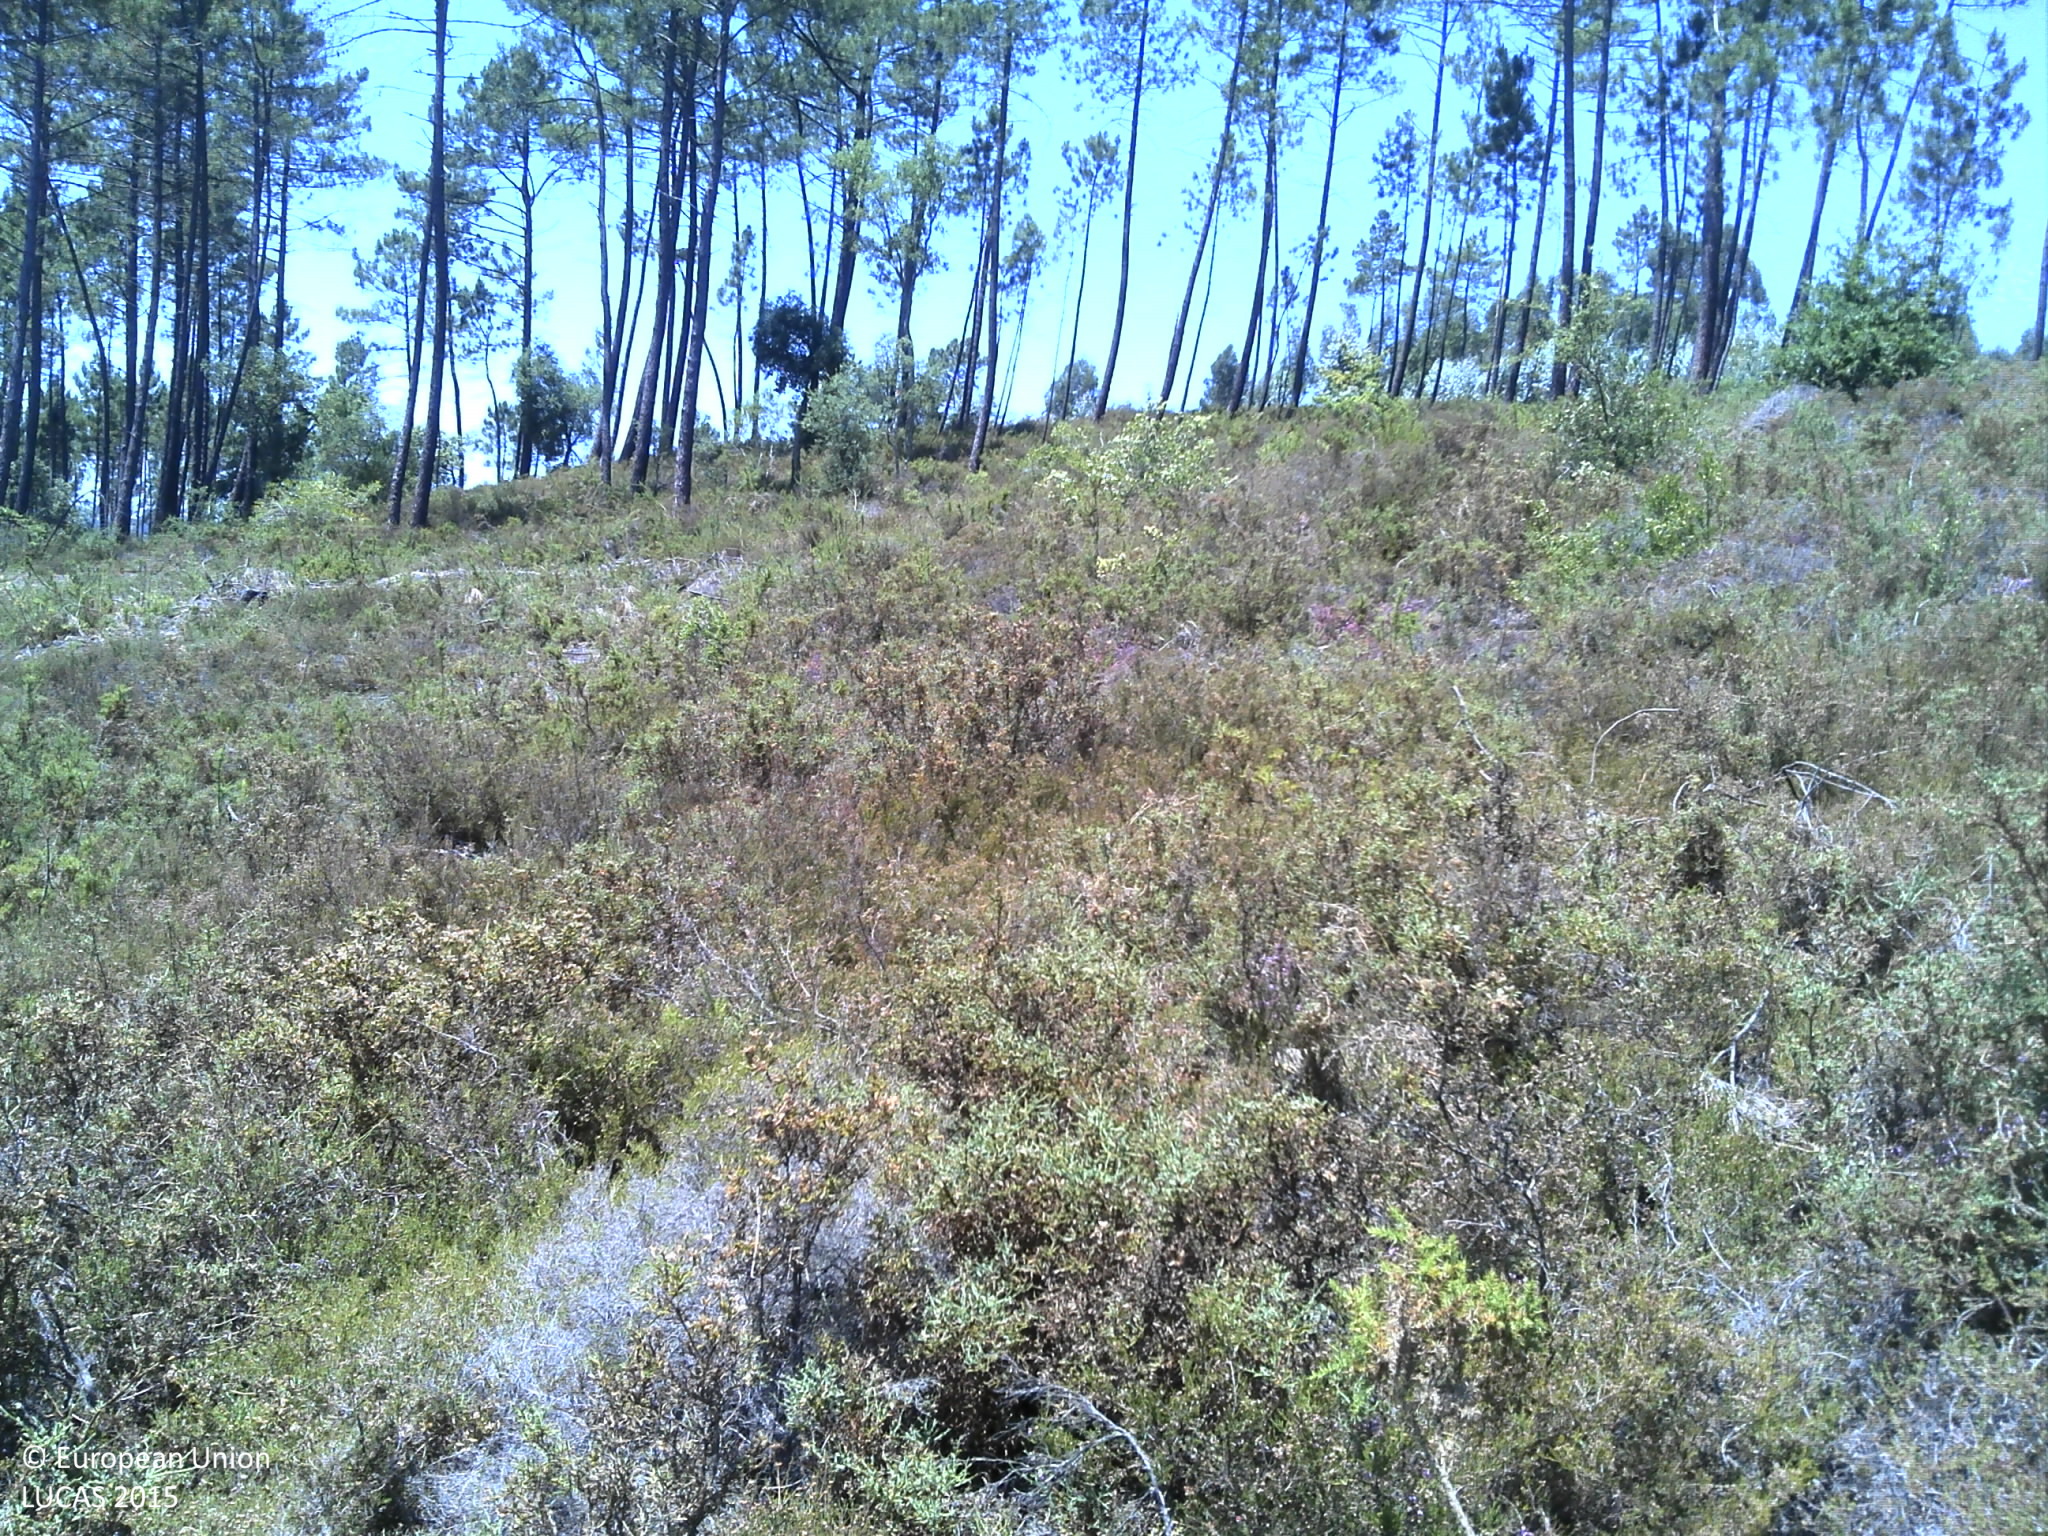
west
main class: Shrubland
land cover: Shrubland without tree cover
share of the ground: > 75 %
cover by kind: shrubs 90 %, unconsolidated bare surface 10 %
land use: Abandoned areas
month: June
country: PT
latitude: 40.1457
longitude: -8.2603
